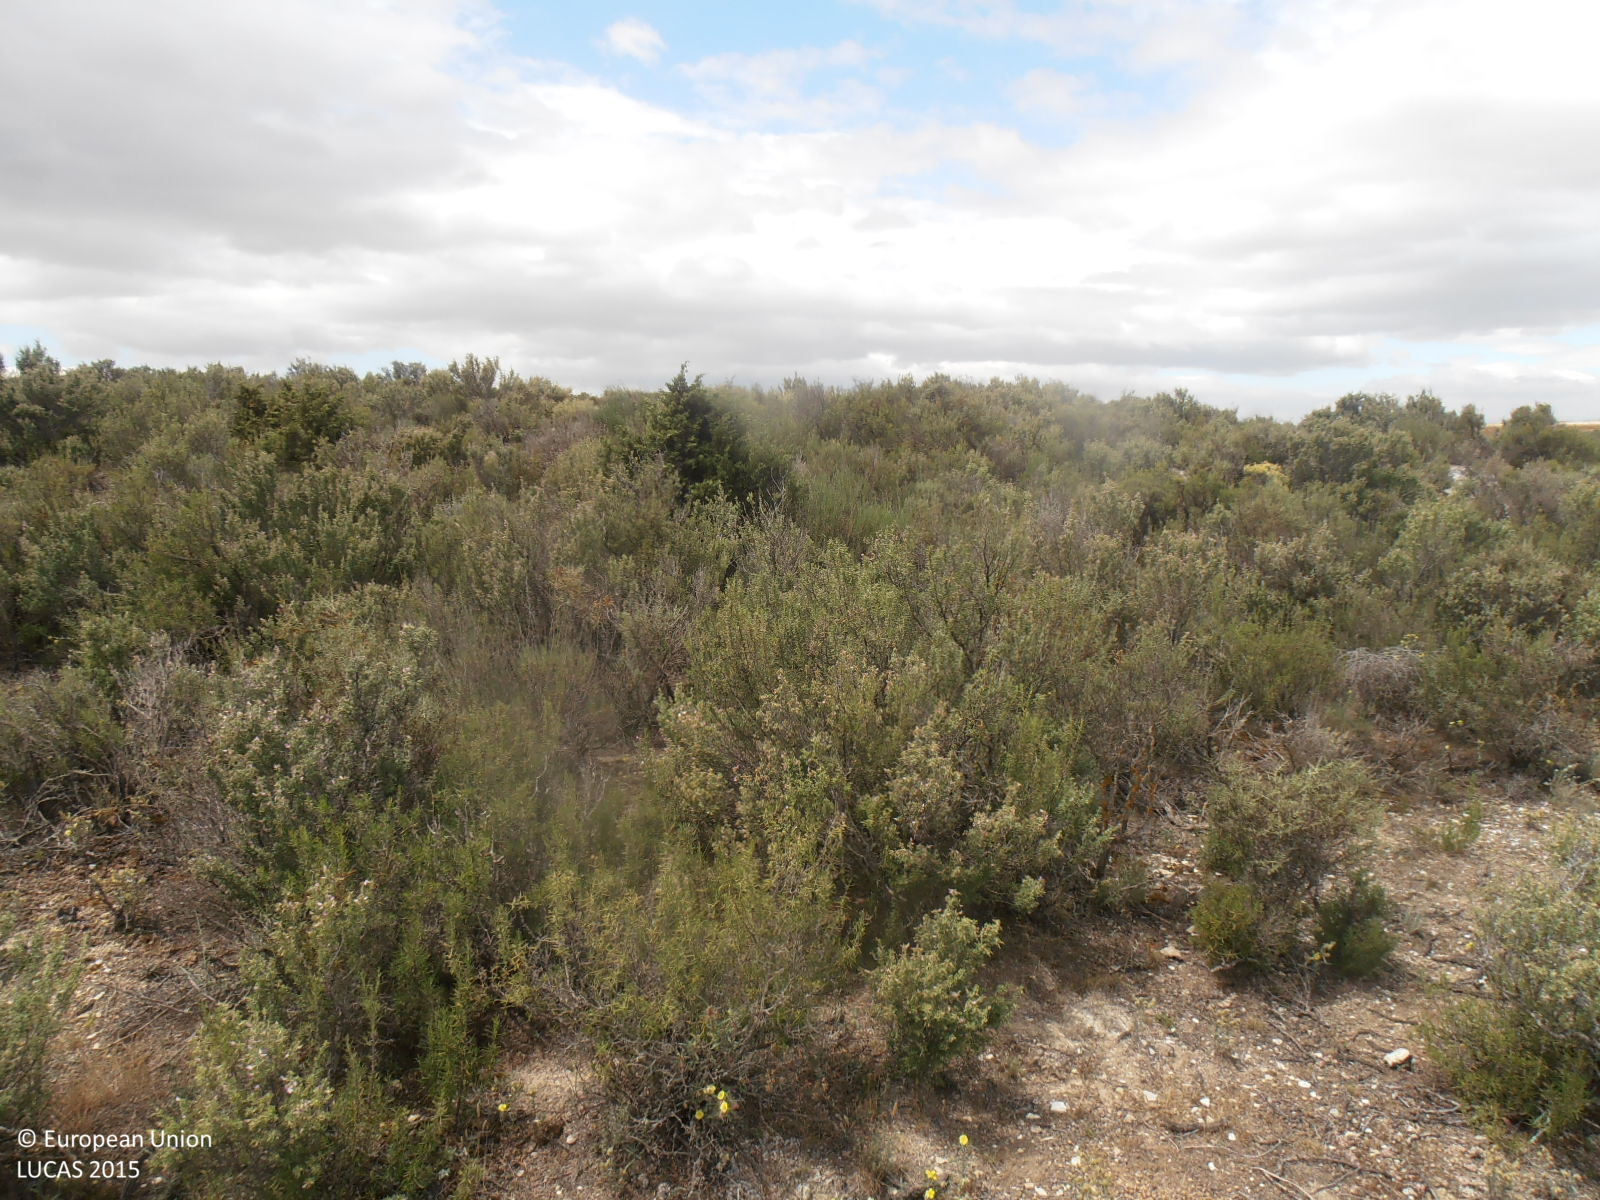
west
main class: Shrubland
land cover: Shrubland without tree cover
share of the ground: 50 - 75 %
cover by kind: shrubs 60 %, consolidated bare surface 40 %
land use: Semi-natural and natural areas not in use
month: June
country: ES
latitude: 41.9317
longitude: -1.1092
